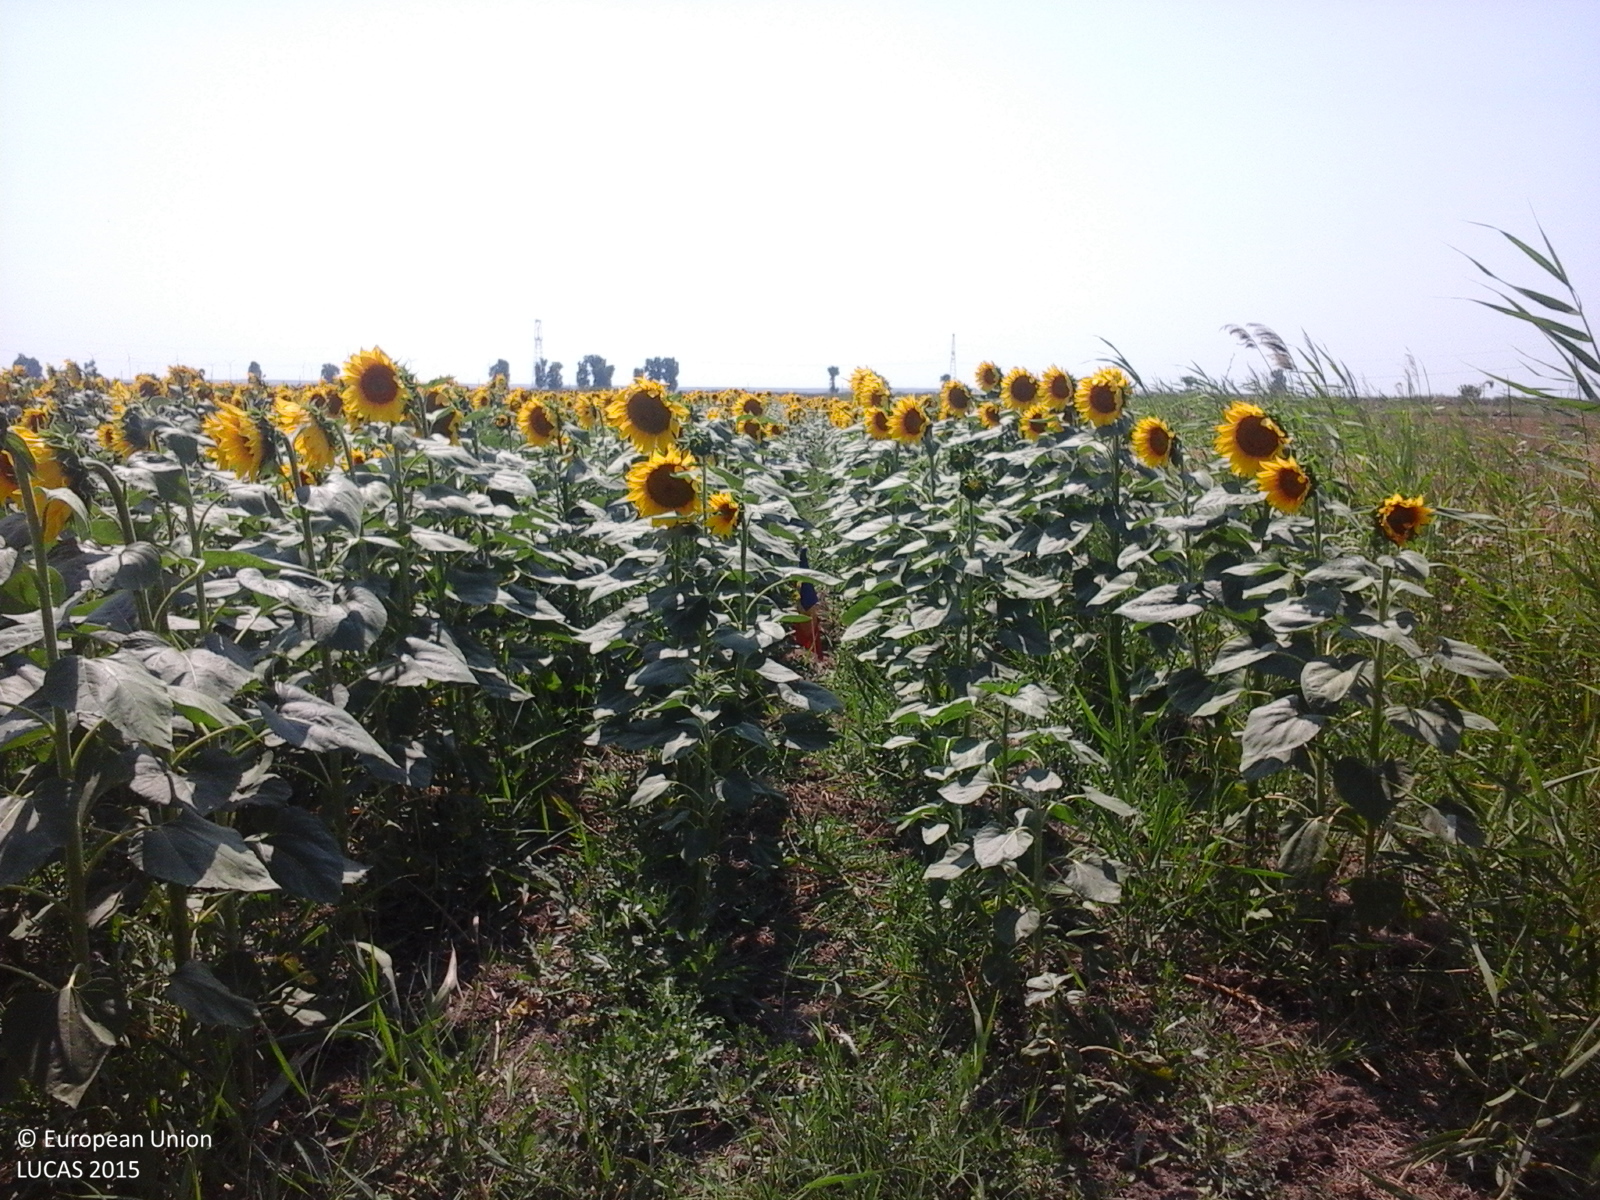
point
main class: Cropland
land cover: Sunflower
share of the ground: > 75 %
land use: Agriculture (excluding fallow land and kitchen gardens)
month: July
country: RO
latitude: 44.6328
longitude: 27.8402
